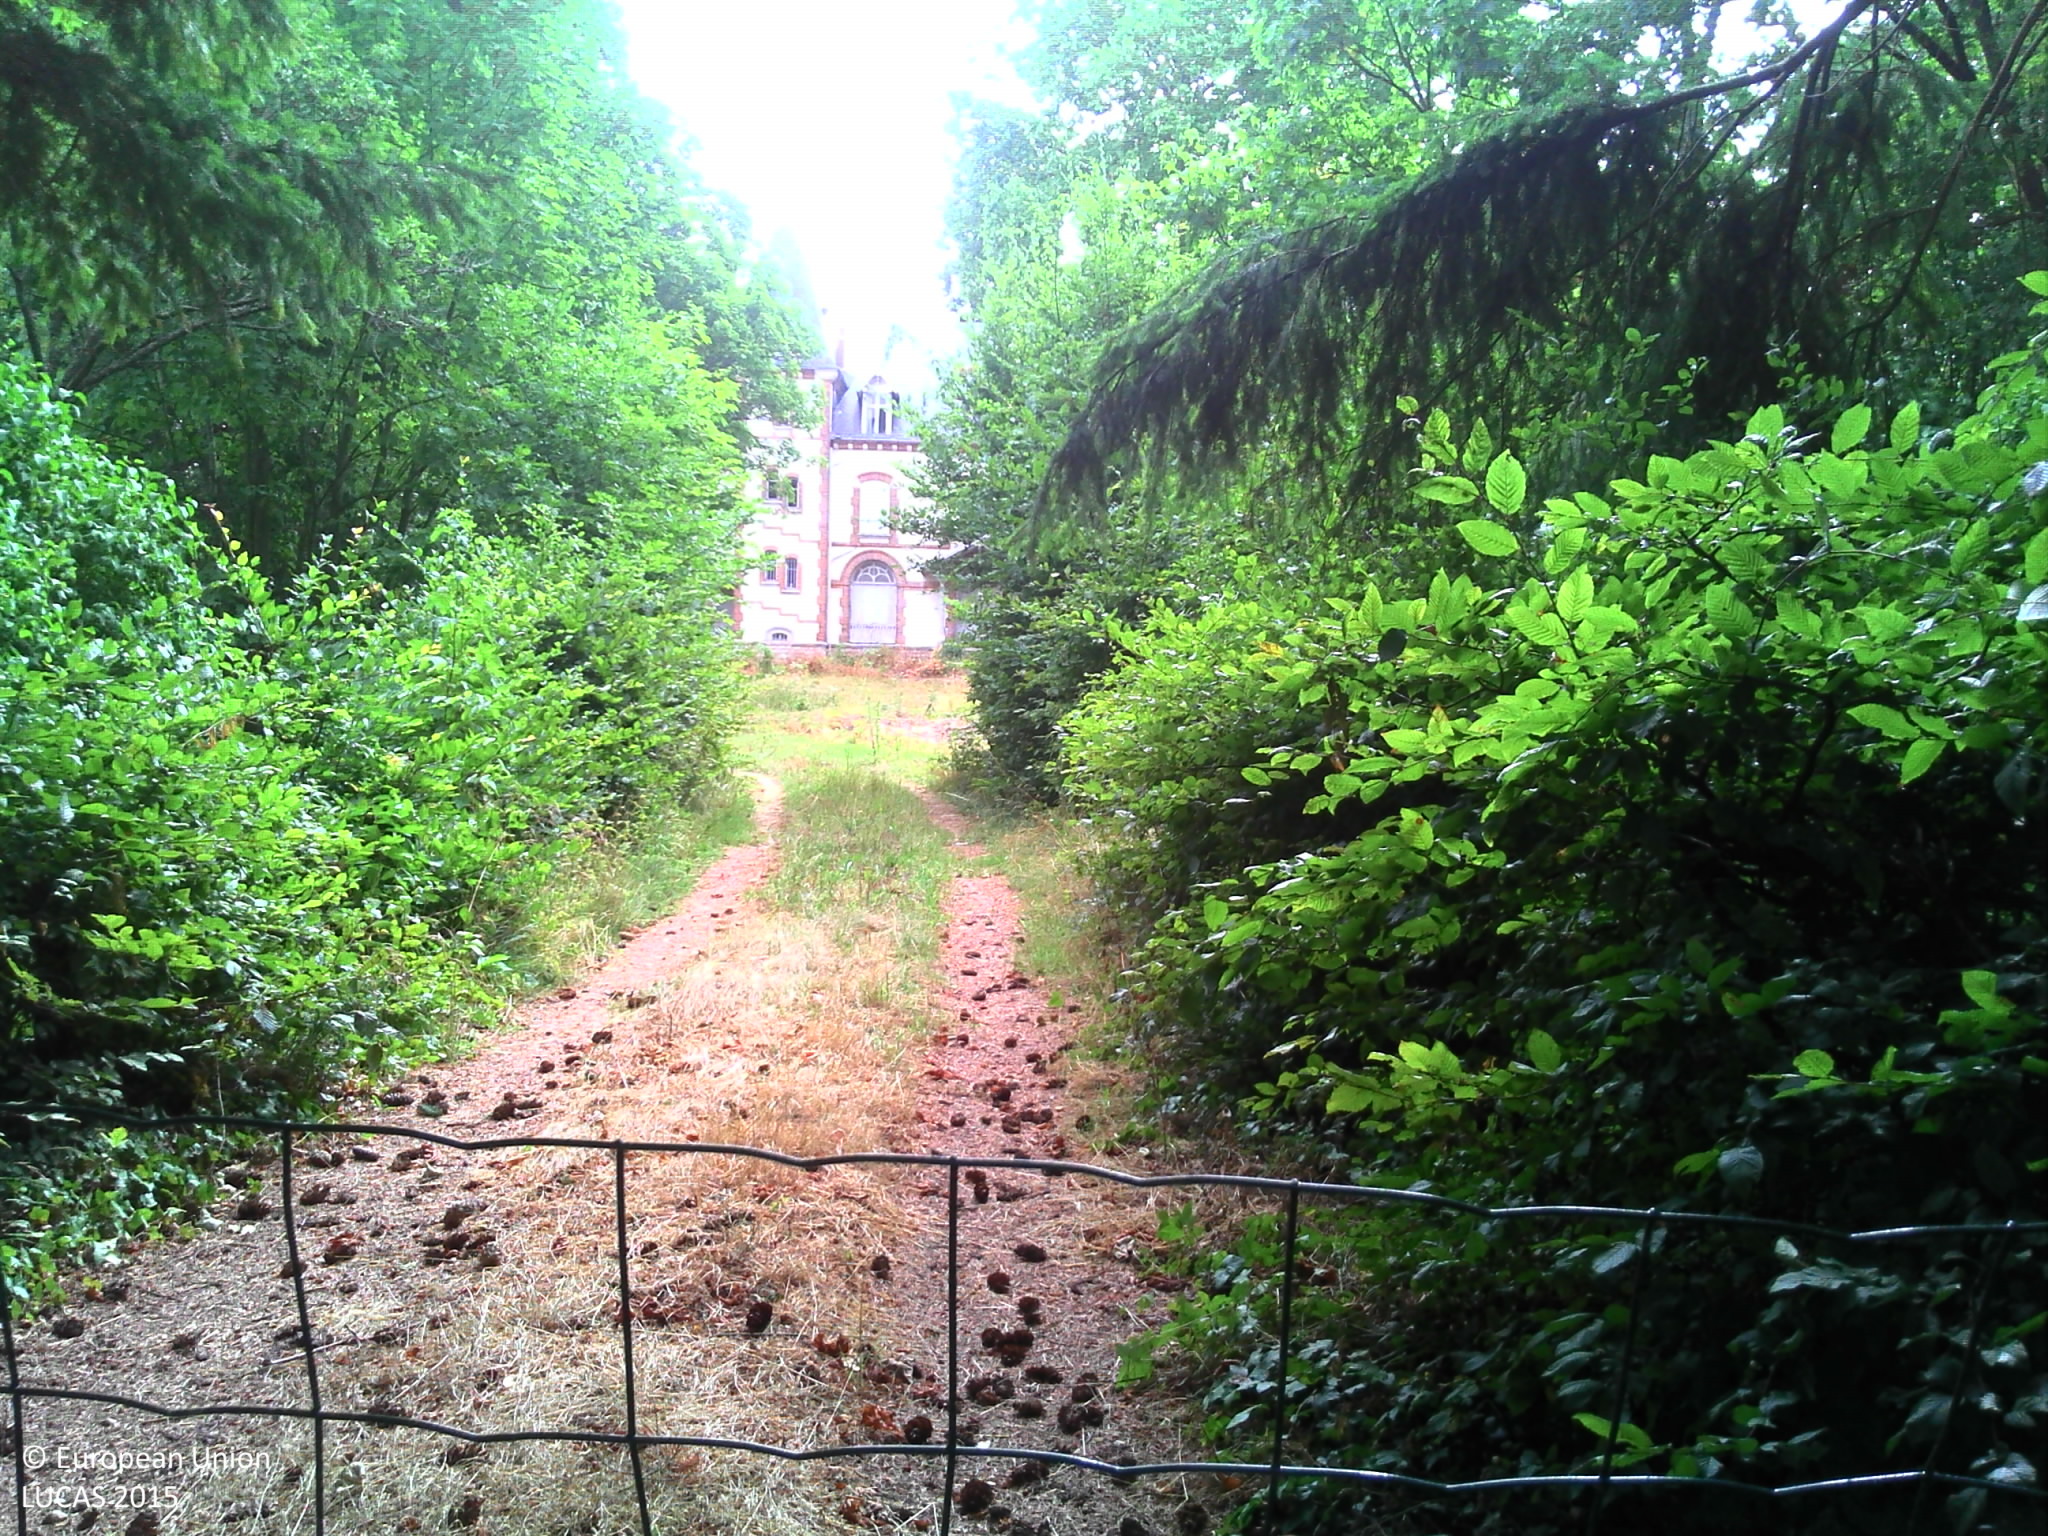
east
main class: Cropland
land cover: Arable land (only in case pi)
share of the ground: > 75 %
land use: Agriculture (excluding fallow land and kitchen gardens)
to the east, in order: Arable land (only in case pi)
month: August
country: FR
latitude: 48.0038
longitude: 1.9857
